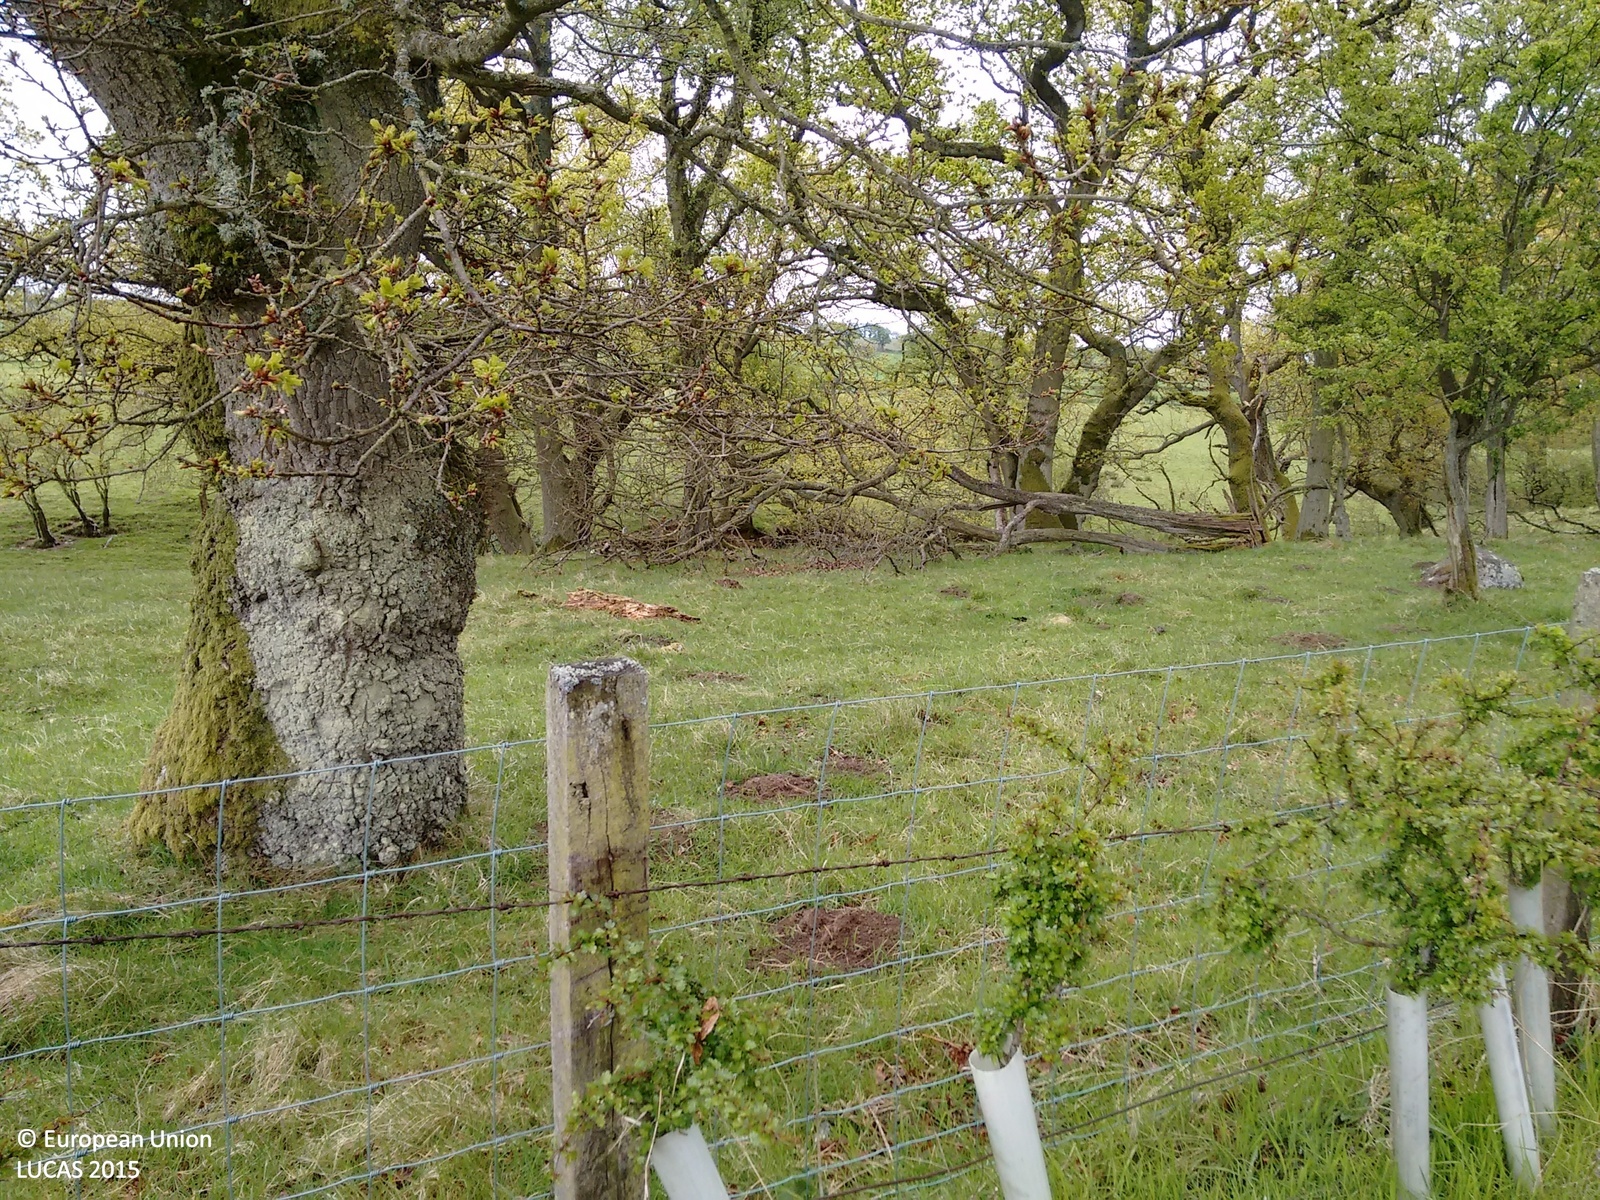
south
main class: Grassland
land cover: Grassland with sparse tree/shrub cover
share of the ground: > 75 %
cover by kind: herbaceous plants 95 %, broadleaved forest trees 5 %
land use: Agriculture (excluding fallow land and kitchen gardens)
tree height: > 5 m
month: May
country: GB
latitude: 55.3765
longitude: -1.7116
